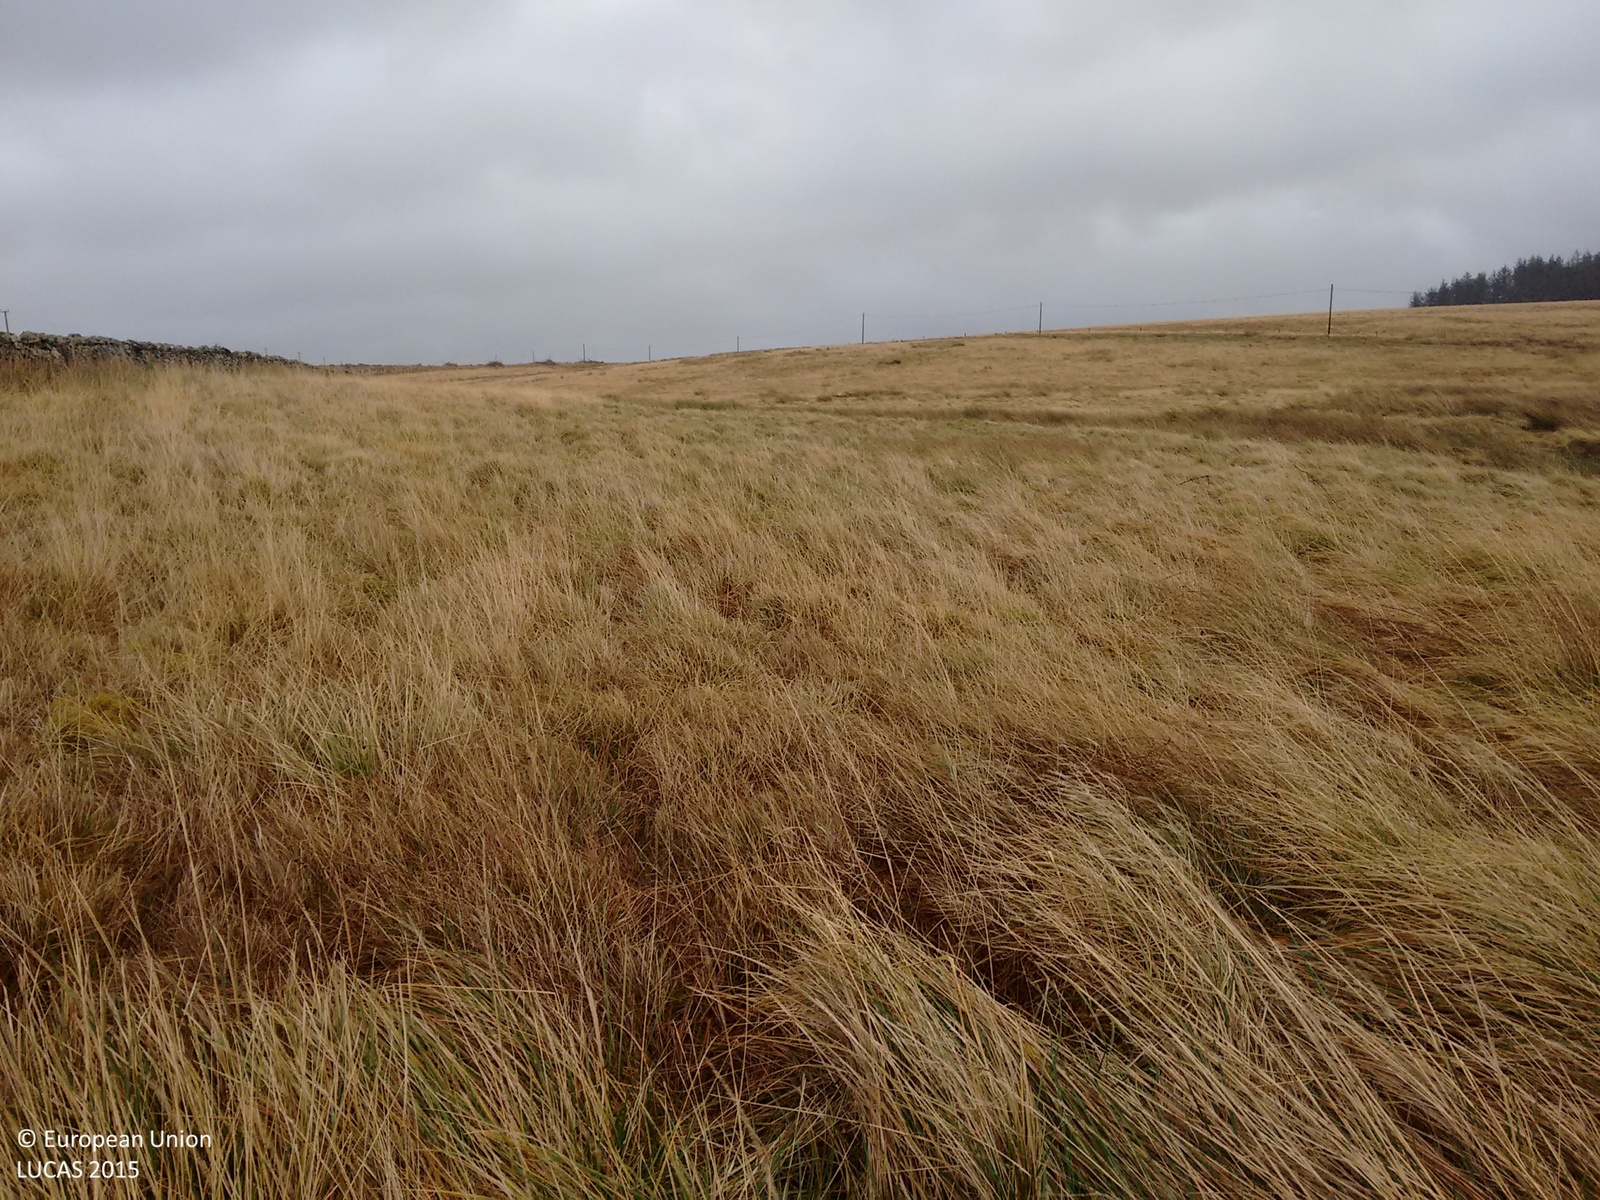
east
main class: Grassland
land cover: Grassland without tree/shrub cover
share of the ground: > 75 %
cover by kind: herbaceous plants 100 %
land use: Agriculture (excluding fallow land and kitchen gardens)
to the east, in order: Grassland without tree/shrub cover; Rivers and streams; Grassland without tree/shrub cover; Paved roads, cycling and walking lanes; Grass margins; Ditches and canals; Electric lines; Grass margins; Fences; Grassland without tree/shrub cover
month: December
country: GB
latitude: 55.4197
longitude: -2.3982
